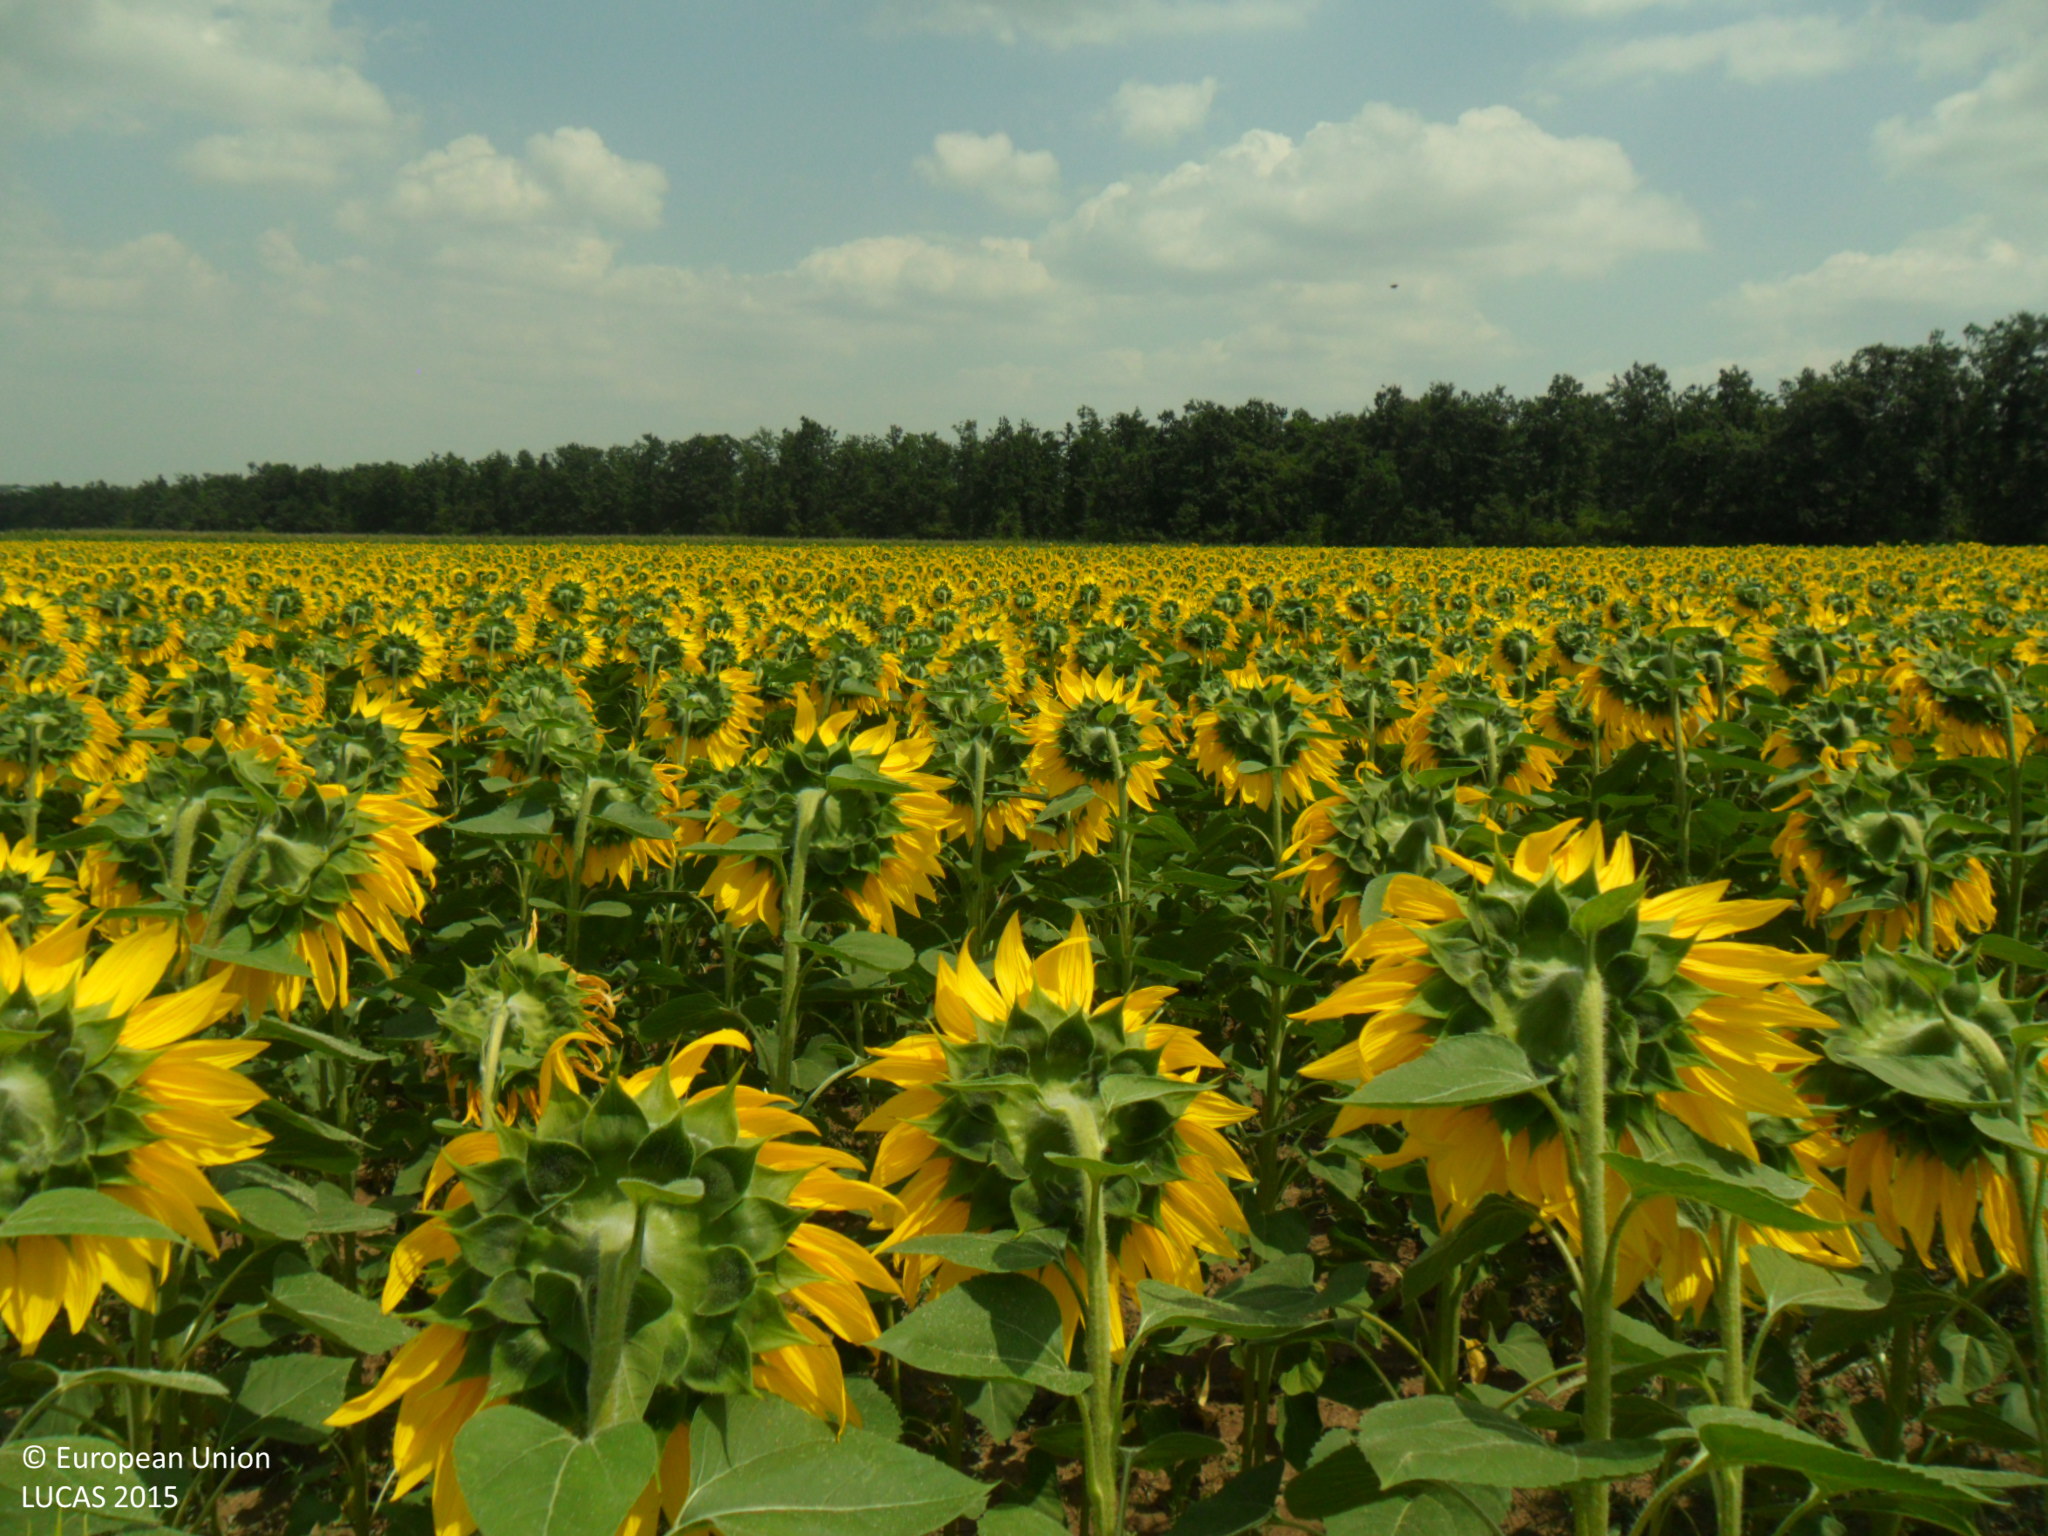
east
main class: Cropland
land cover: Sunflower
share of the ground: > 75 %
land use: Agriculture (excluding fallow land and kitchen gardens)
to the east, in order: Sunflower; Maize; Grass margins; Tracks; Grass margins; Broadleaved woodland
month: July
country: BG
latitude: 43.5838
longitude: 26.9732
